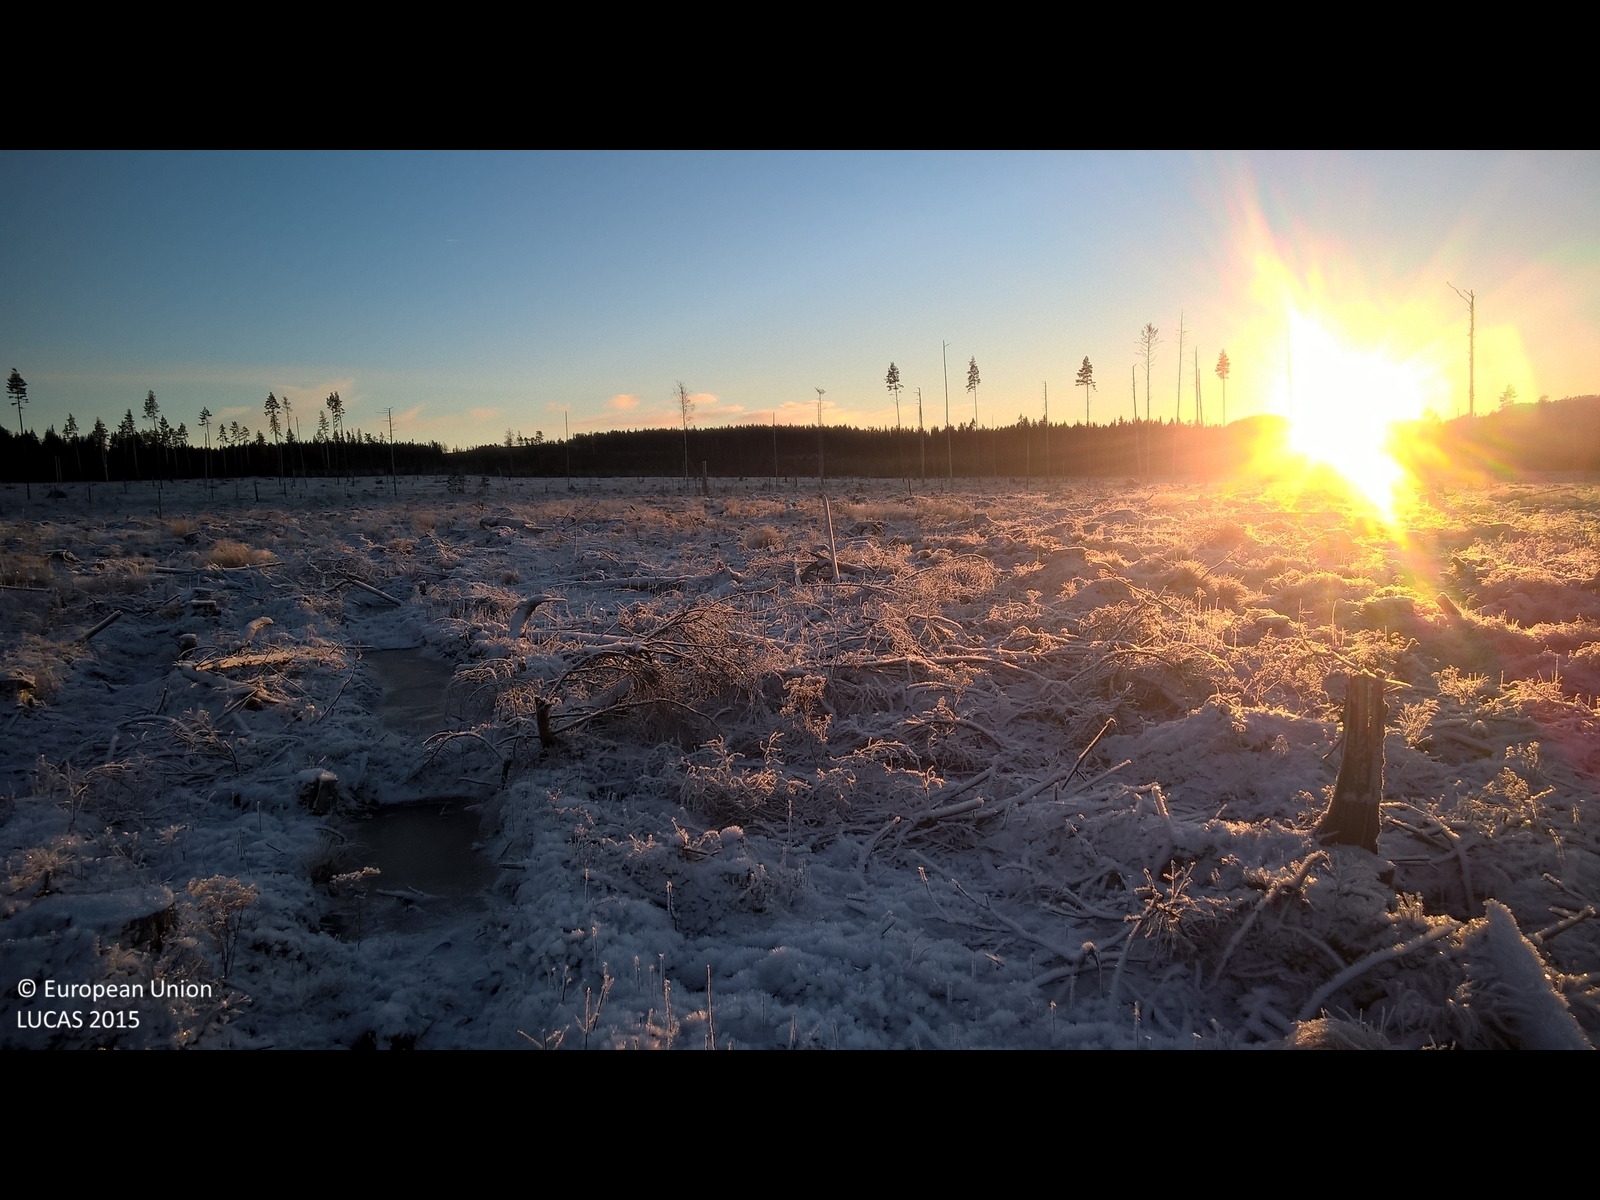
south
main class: Grassland
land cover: Grassland with sparse tree/shrub cover
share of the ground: 10 - 25 %
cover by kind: lichens and mosses 75 %, herbaceous plants 15 %, coniferous forest trees 5 %, shrubs 5 %
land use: Forestry
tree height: > 5 m
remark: Clear cut
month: November
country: SE
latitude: 60.3881
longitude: 14.2162
